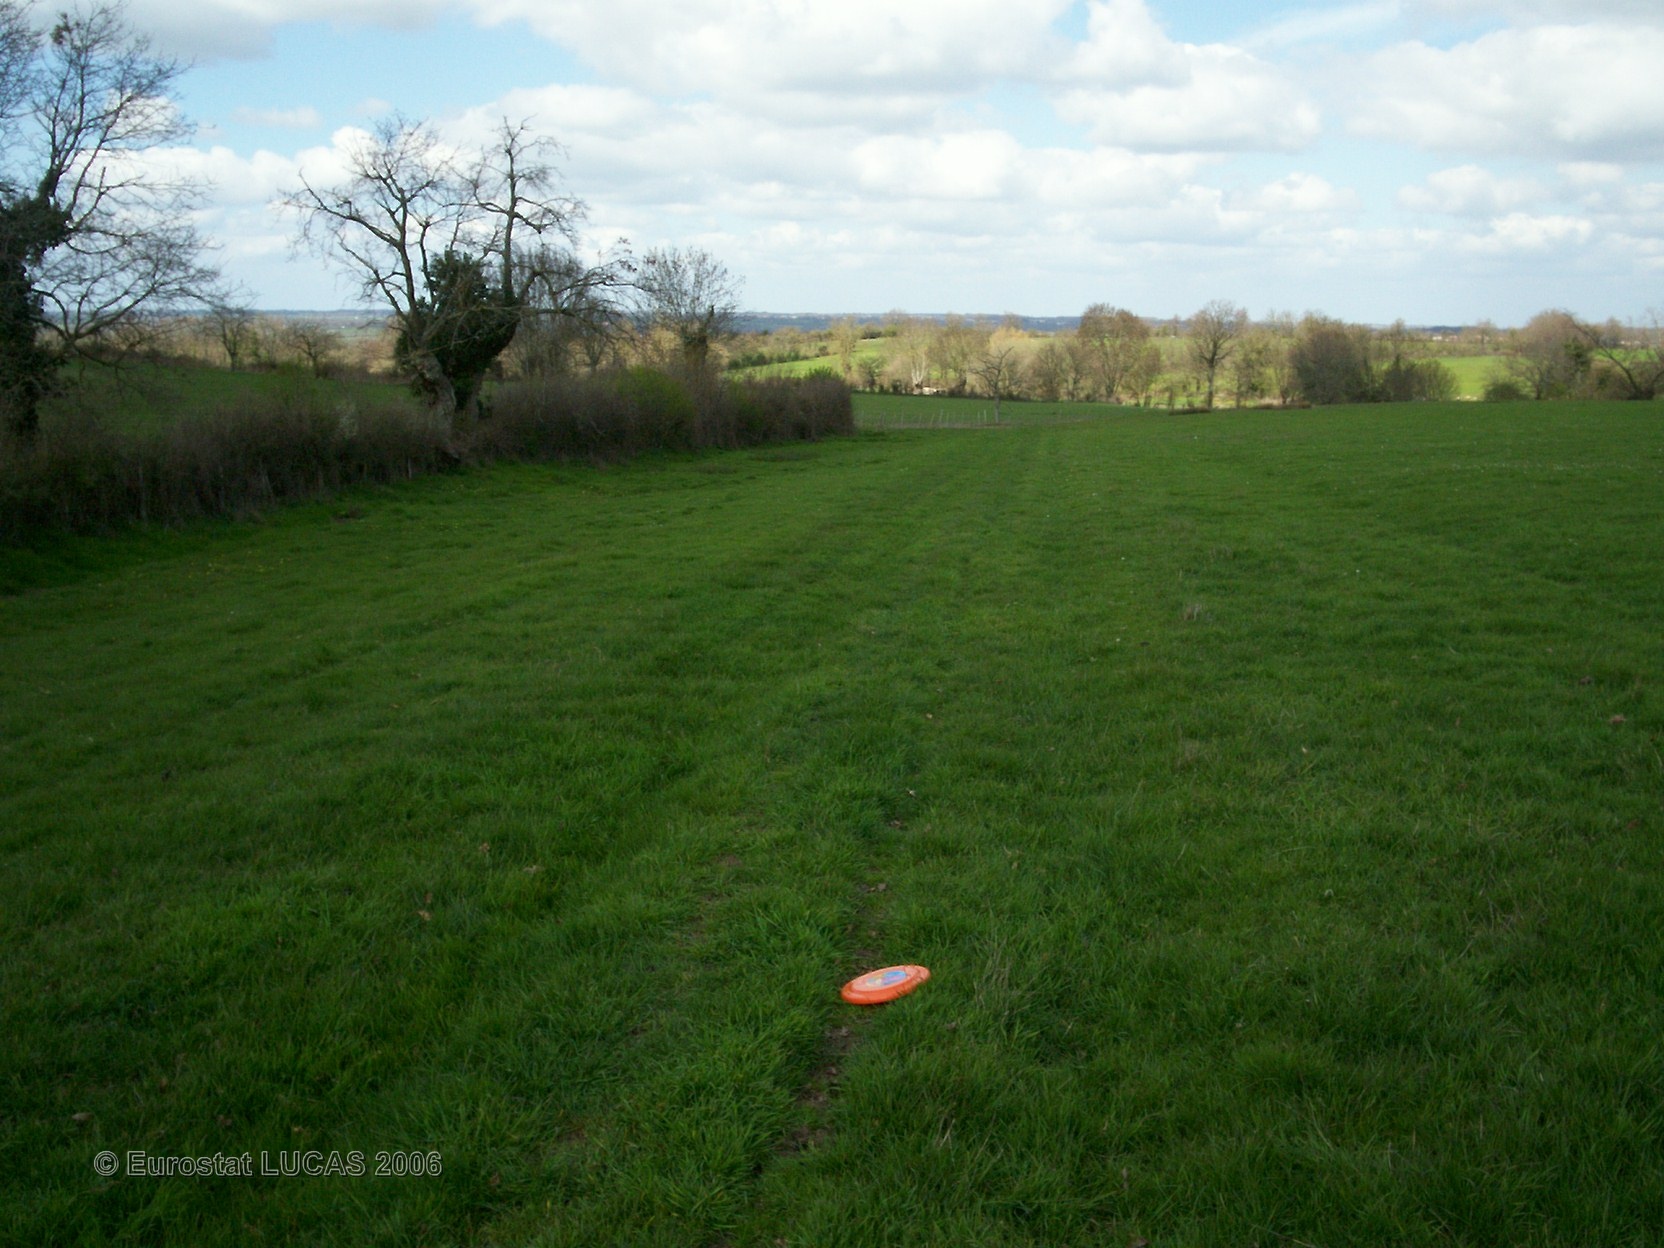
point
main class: Grassland
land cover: Grassland without tree/shrub cover
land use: Agriculture (excluding fallow land and kitchen gardens)
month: April
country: FR
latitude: 46.7726
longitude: -0.3589
